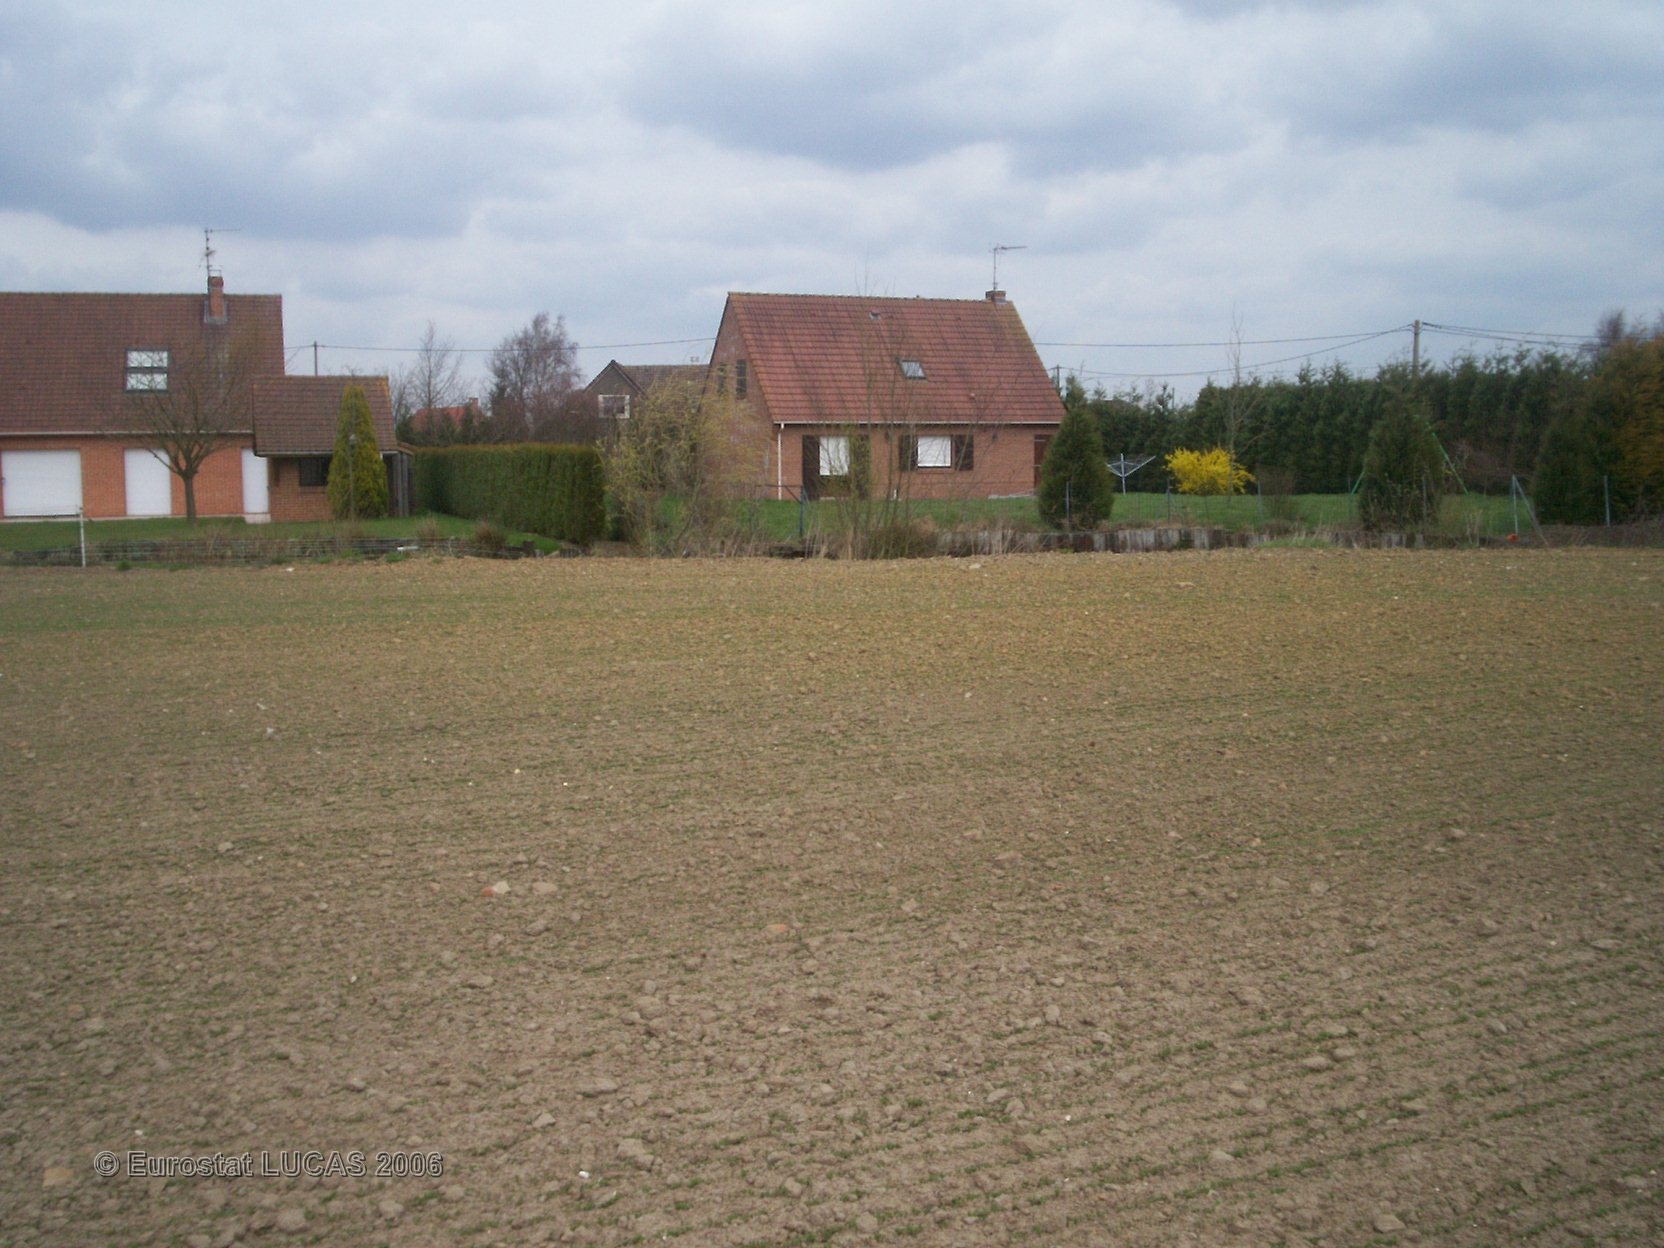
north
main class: Cropland
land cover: Sugar beet
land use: Agriculture (excluding fallow land and kitchen gardens)
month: April
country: FR
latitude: 50.7293
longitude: 2.4643
